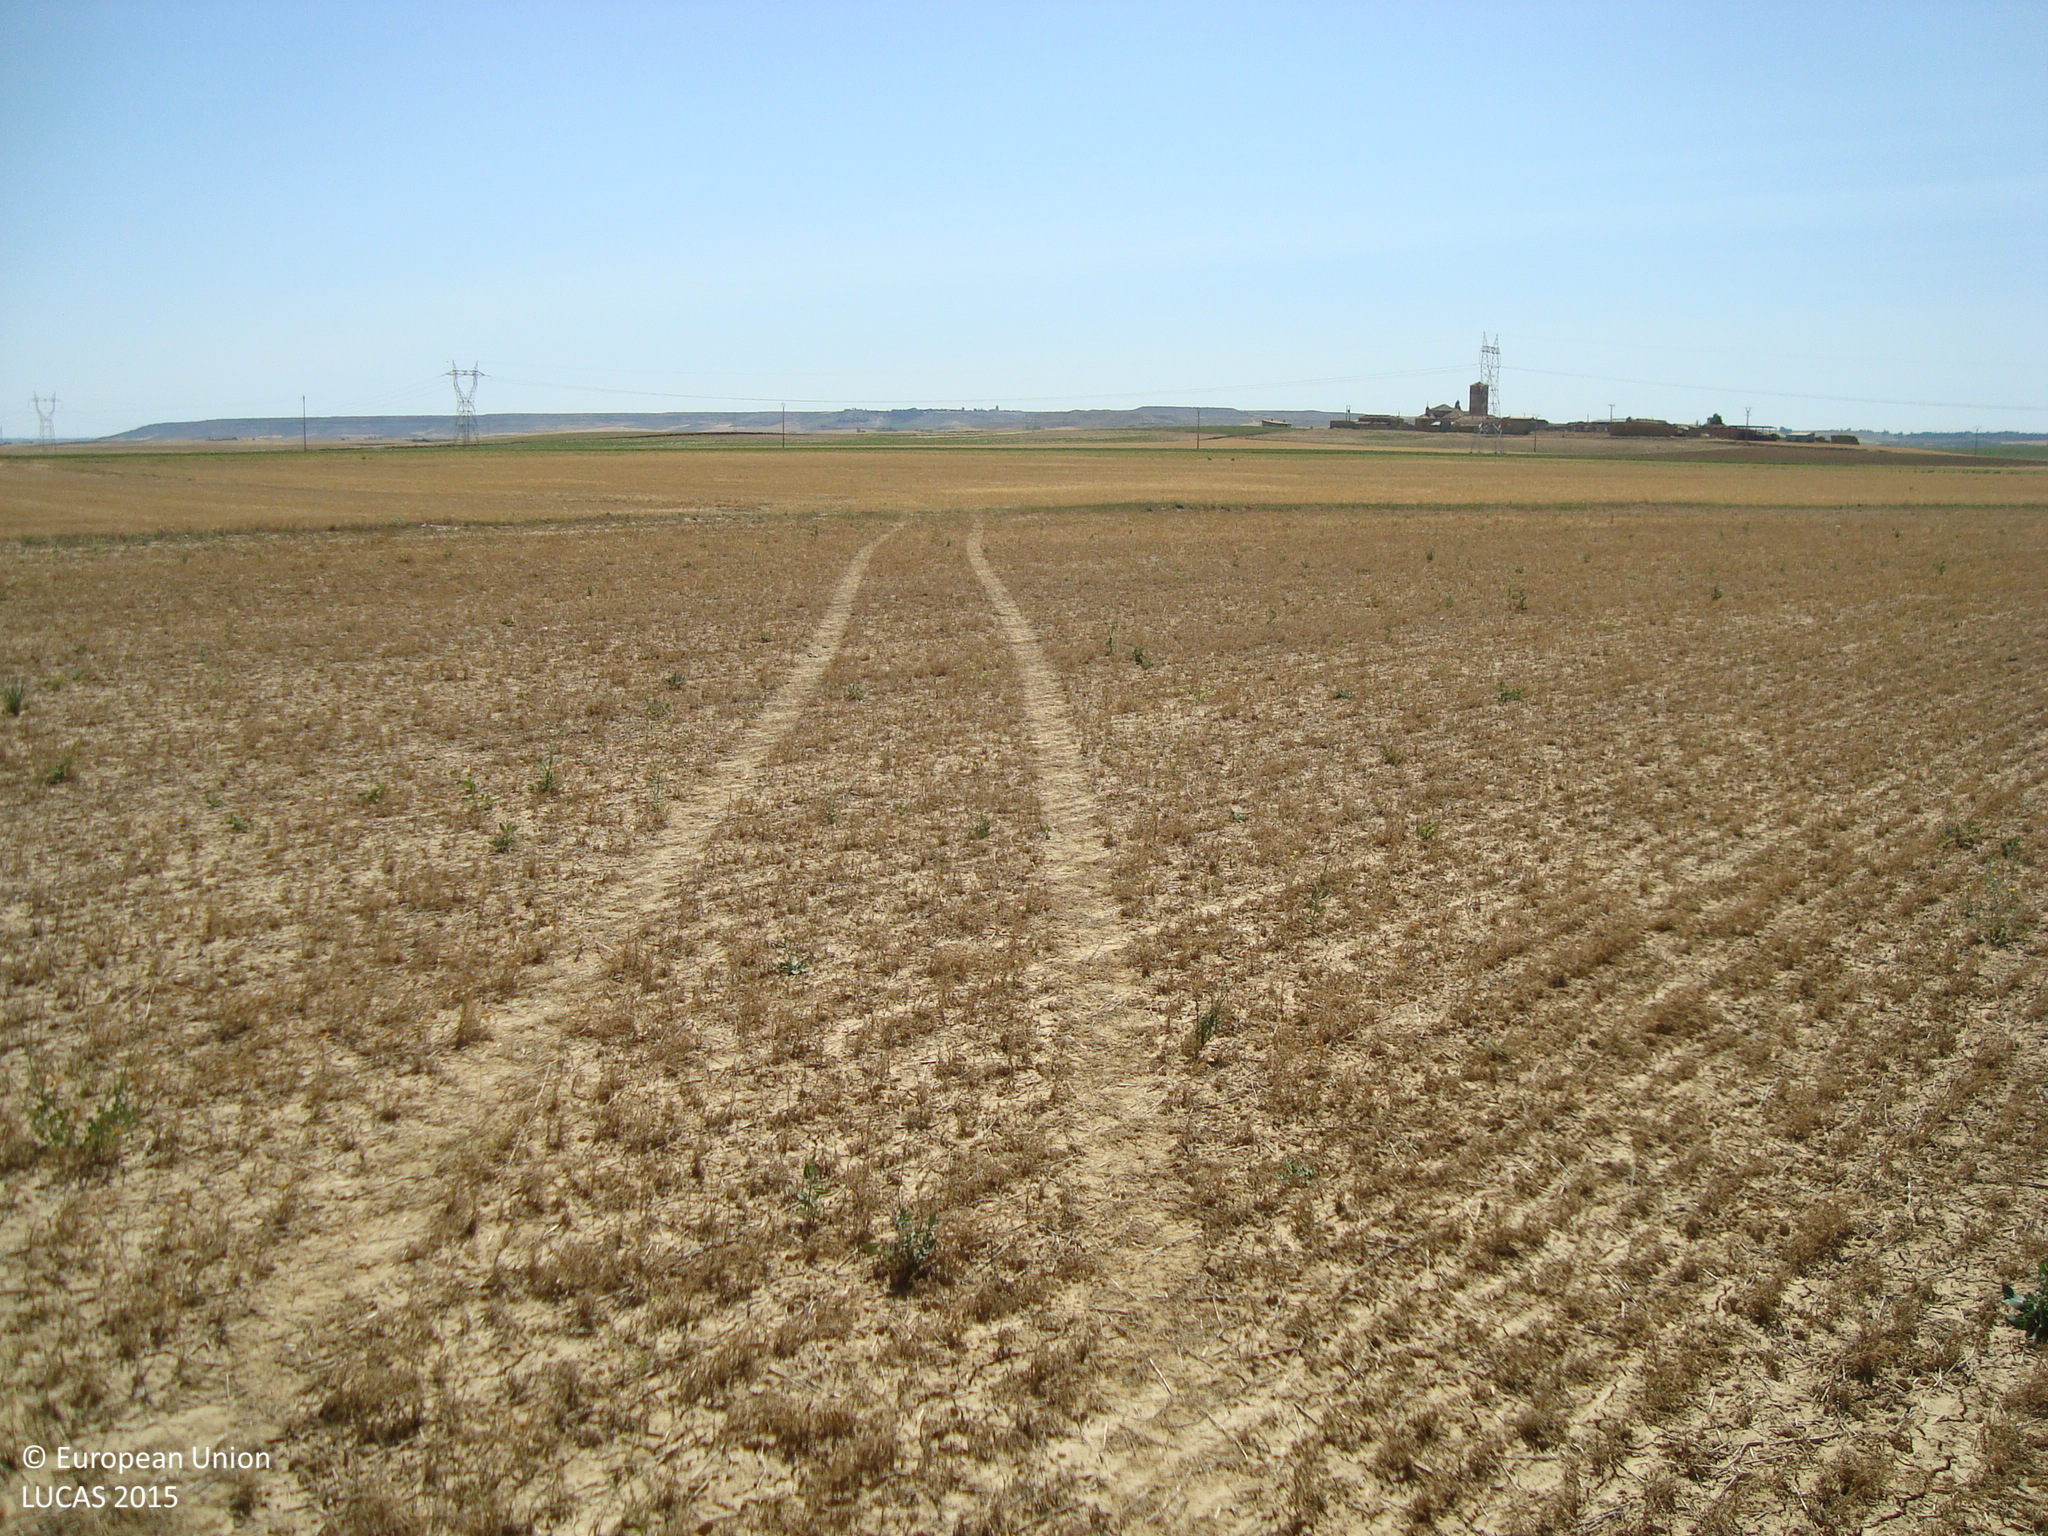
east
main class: Cropland
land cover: Dry pulses
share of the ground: < 10 %
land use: Agriculture (excluding fallow land and kitchen gardens)
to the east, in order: Dry pulses; Tracks; Barley; Tracks; Barley
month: July
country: ES
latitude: 42.0116
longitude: -4.7205
